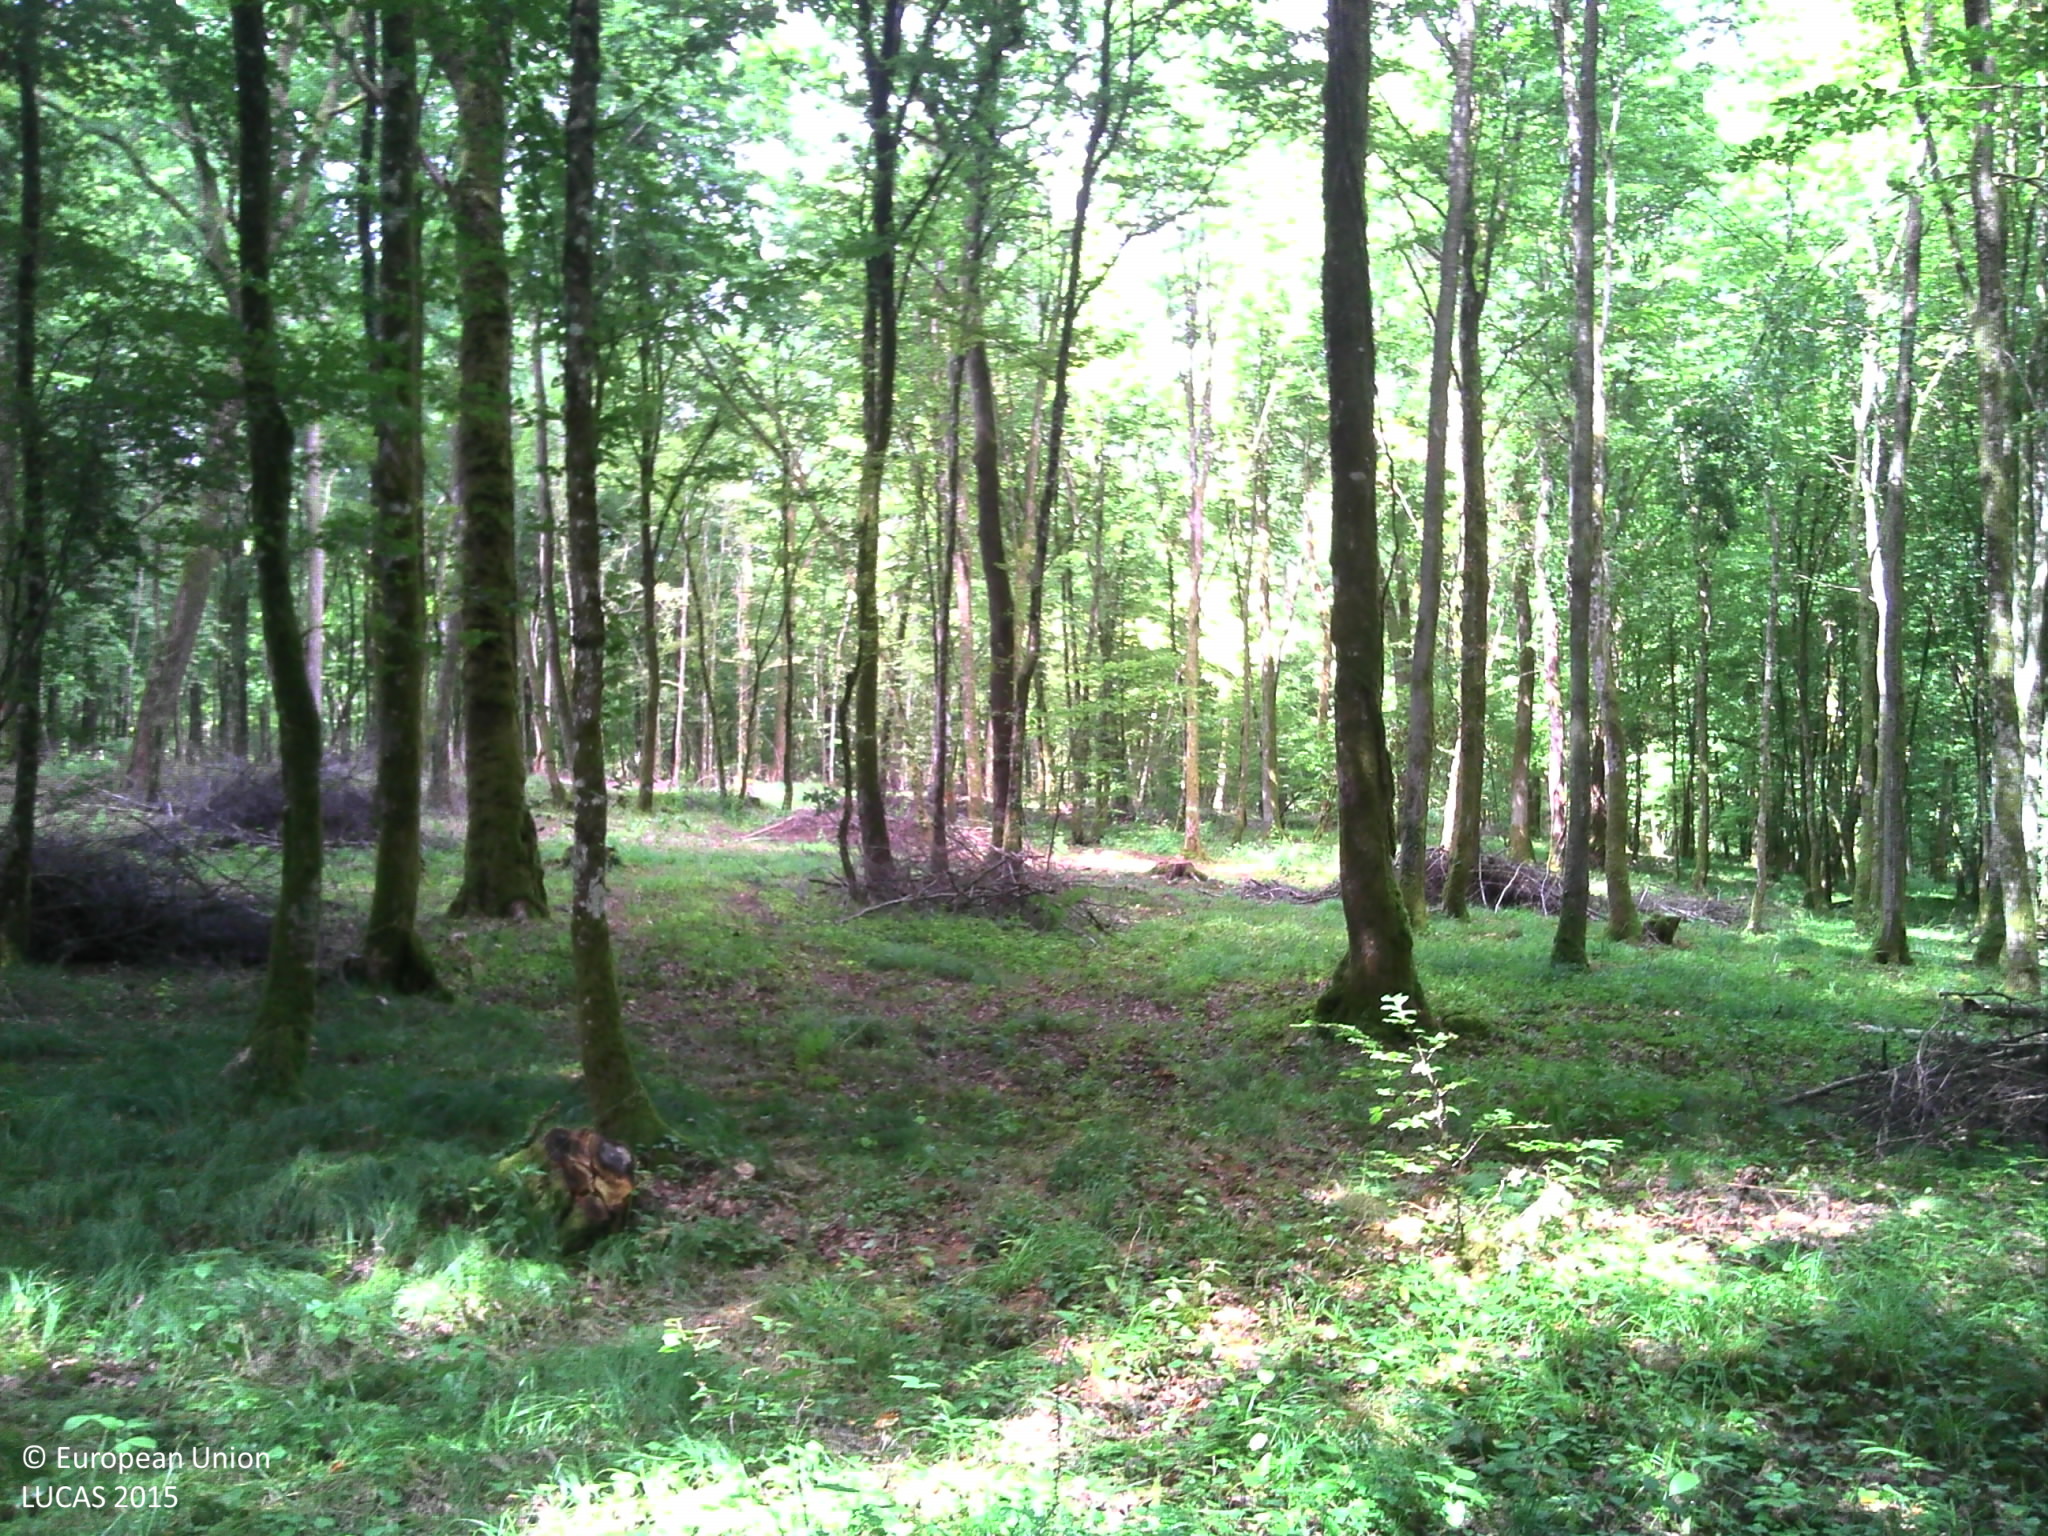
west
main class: Woodland
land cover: Broadleaved woodland
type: mesophytic deciduous forest
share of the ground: > 75 %
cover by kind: broadleaved forest trees 95 %, herbaceous plants 5 %
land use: Forestry
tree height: > 5 m
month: July
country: FR
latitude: 49.2140
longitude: 5.0971
